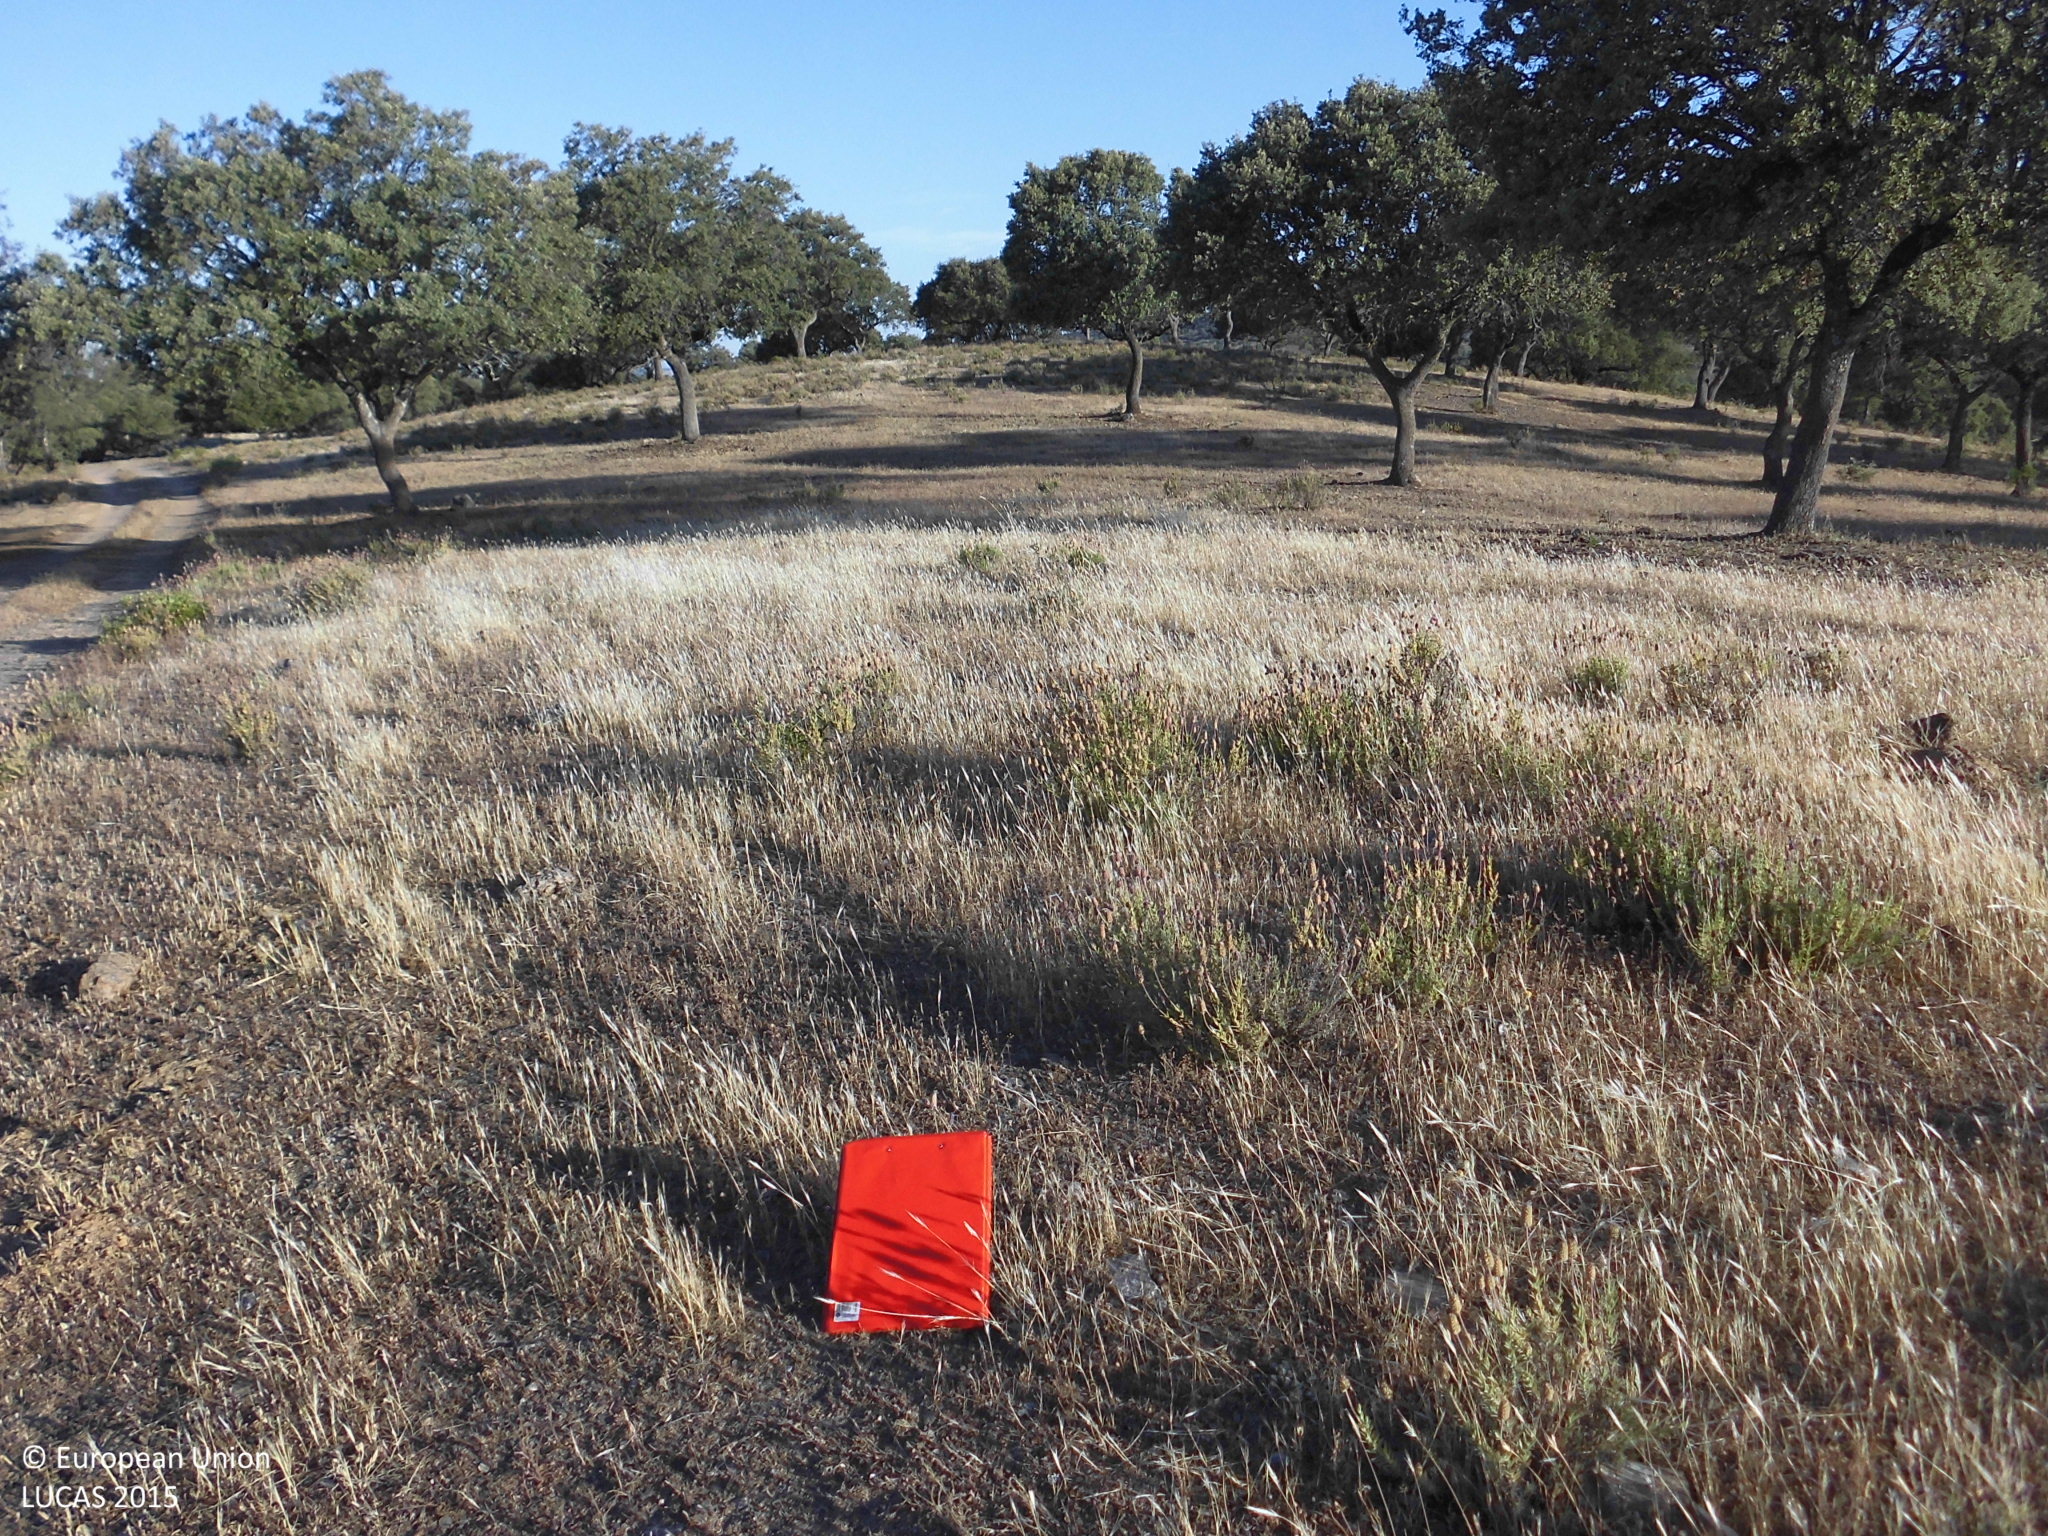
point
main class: Woodland
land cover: Broadleaved woodland
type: broadleaved evergreen forest
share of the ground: 10 - 25 %
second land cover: Grassland without tree/shrub cover
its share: > 75 %
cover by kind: herbaceous plants 80 %, broadleaved forest trees 15 %, consolidated bare surface 5 %
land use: Forestry
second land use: Agriculture (excluding fallow land and kitchen gardens)
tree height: > 5 m
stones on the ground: 10 - 25 %
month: May
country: ES
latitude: 39.7749
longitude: -6.9560
